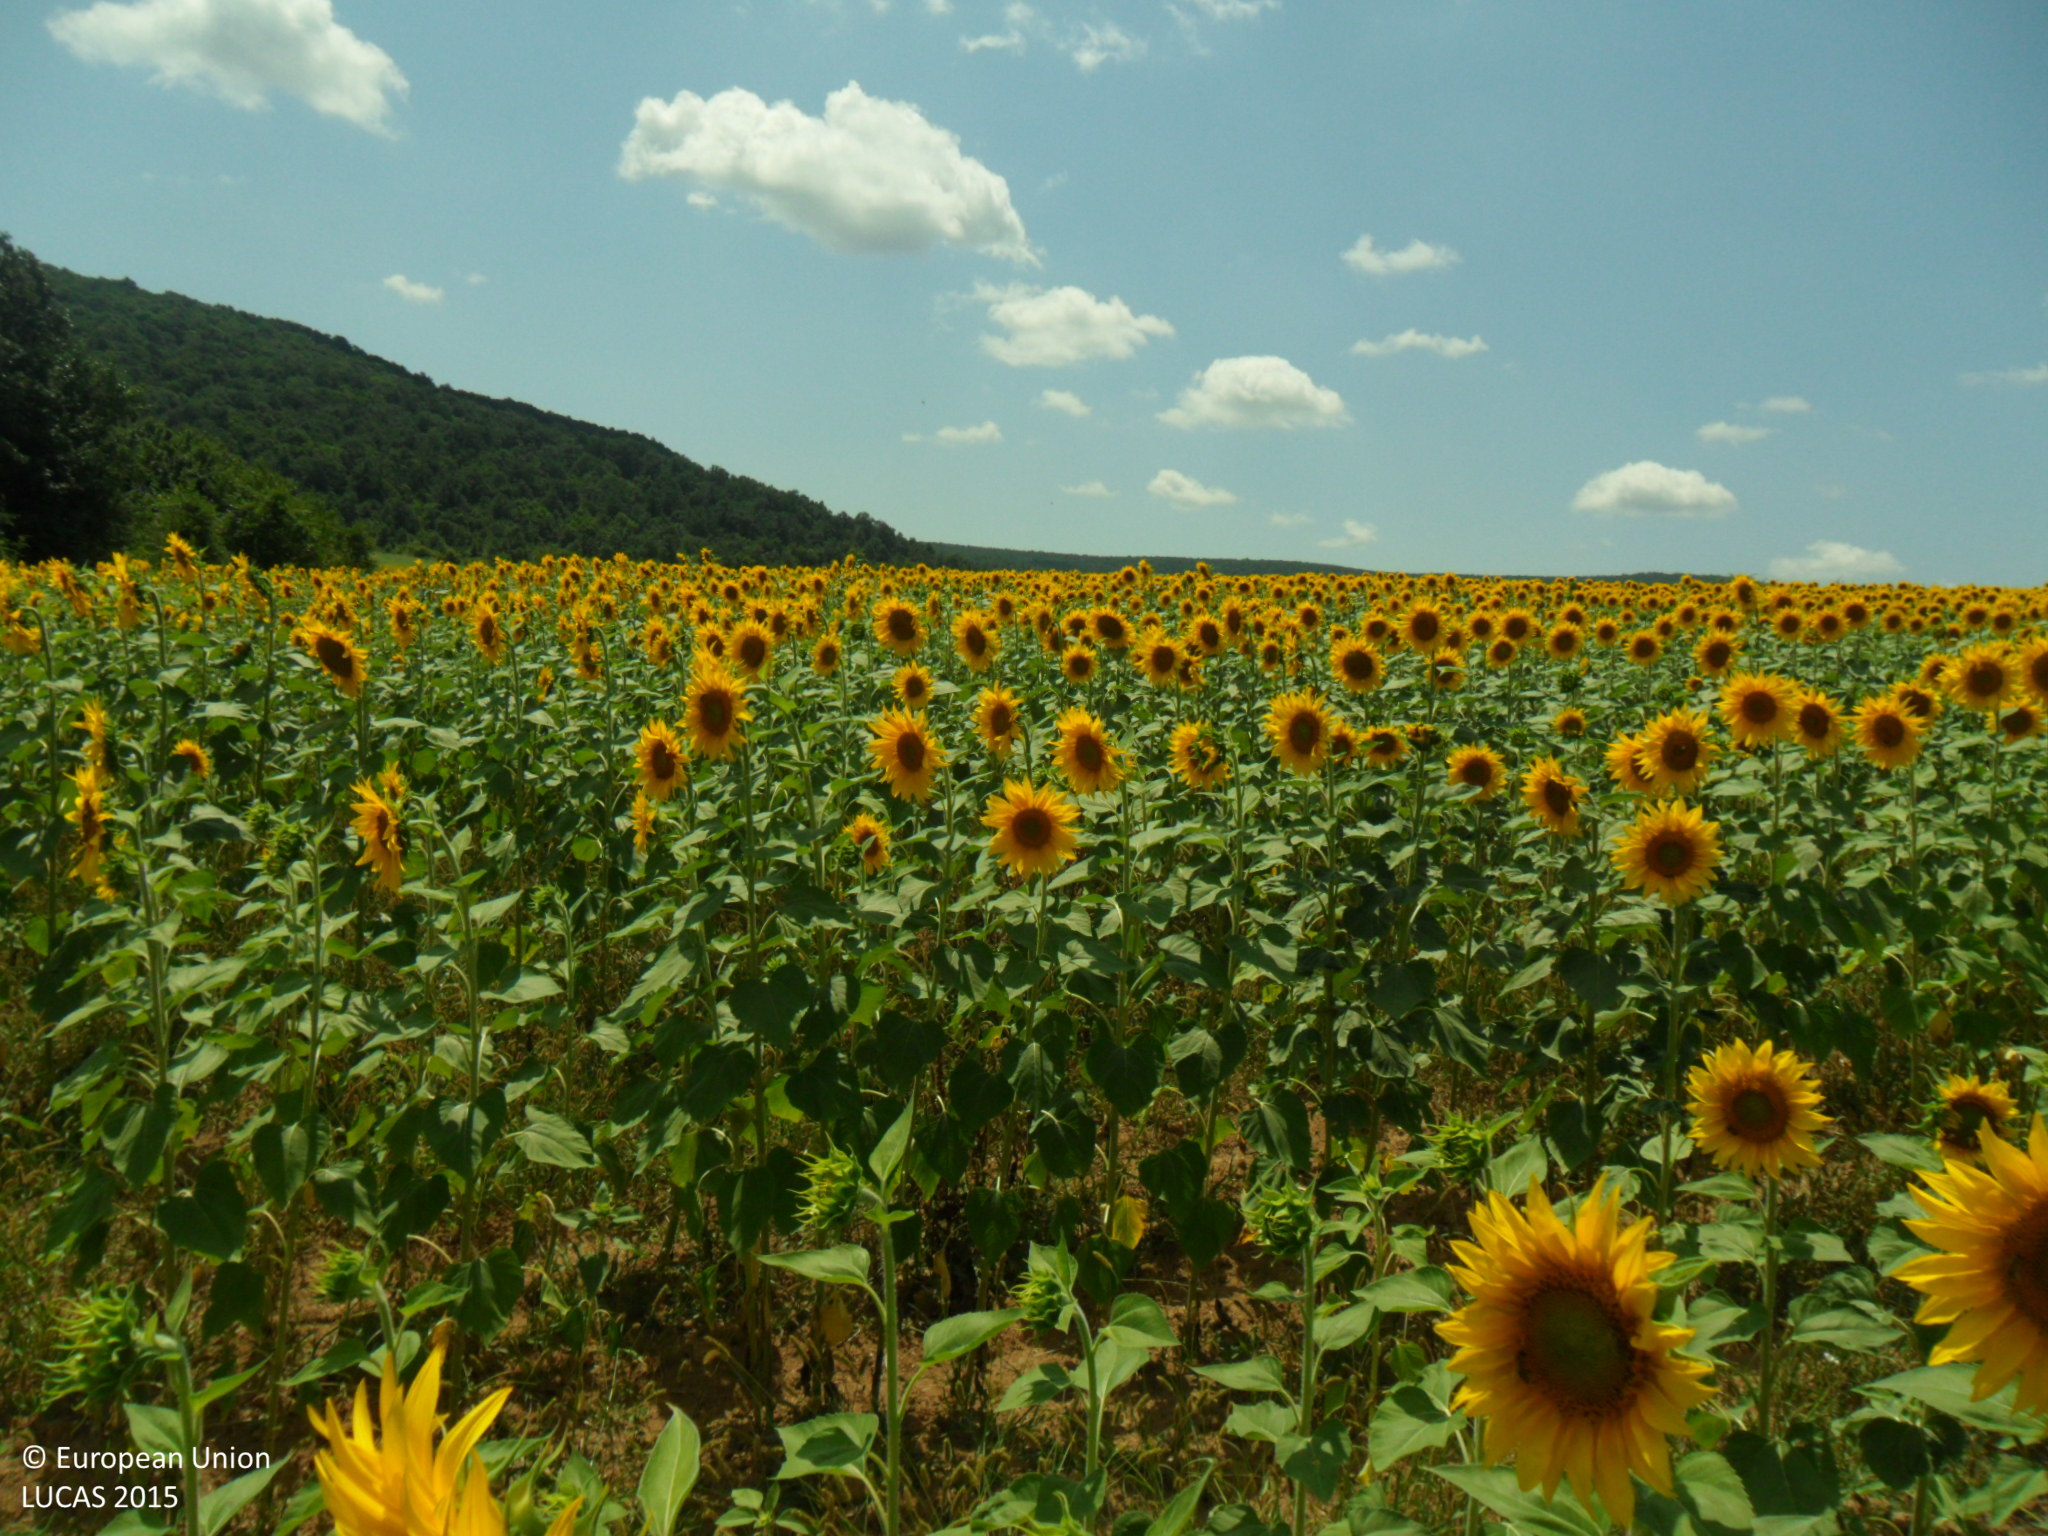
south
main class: Cropland
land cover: Sunflower
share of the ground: > 75 %
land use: Agriculture (excluding fallow land and kitchen gardens)
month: July
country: BG
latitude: 43.0431
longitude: 27.0152
